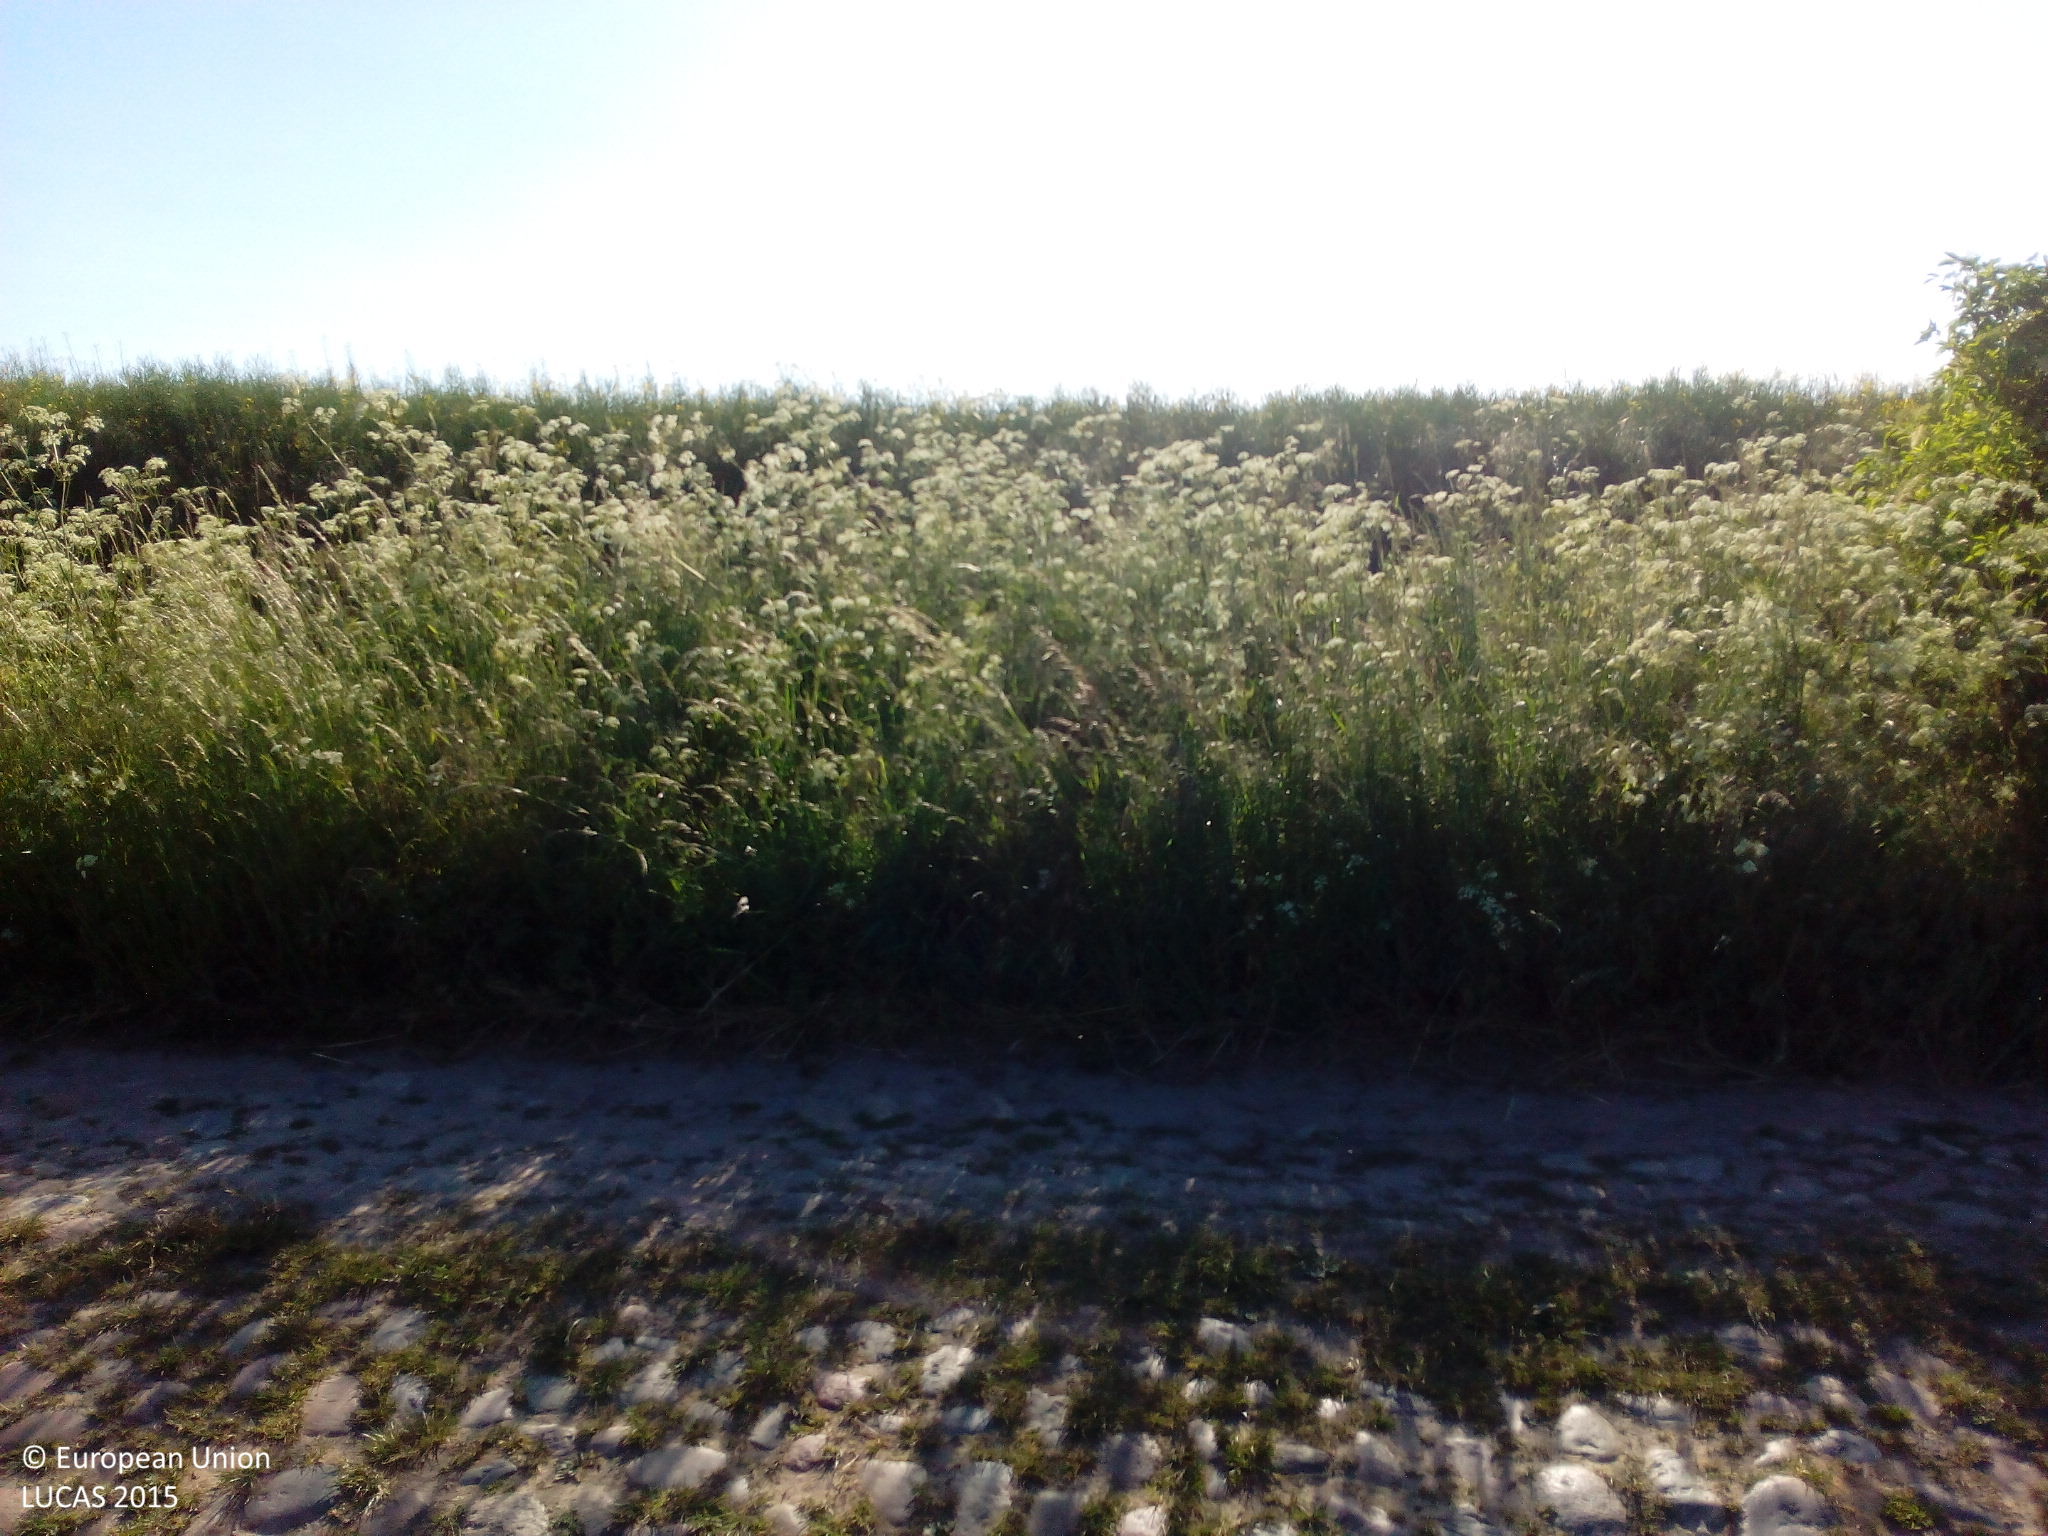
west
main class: Cropland
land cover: Rye
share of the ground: > 75 %
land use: Agriculture (excluding fallow land and kitchen gardens)
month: June
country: DE
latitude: 53.2712
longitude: 12.3535
